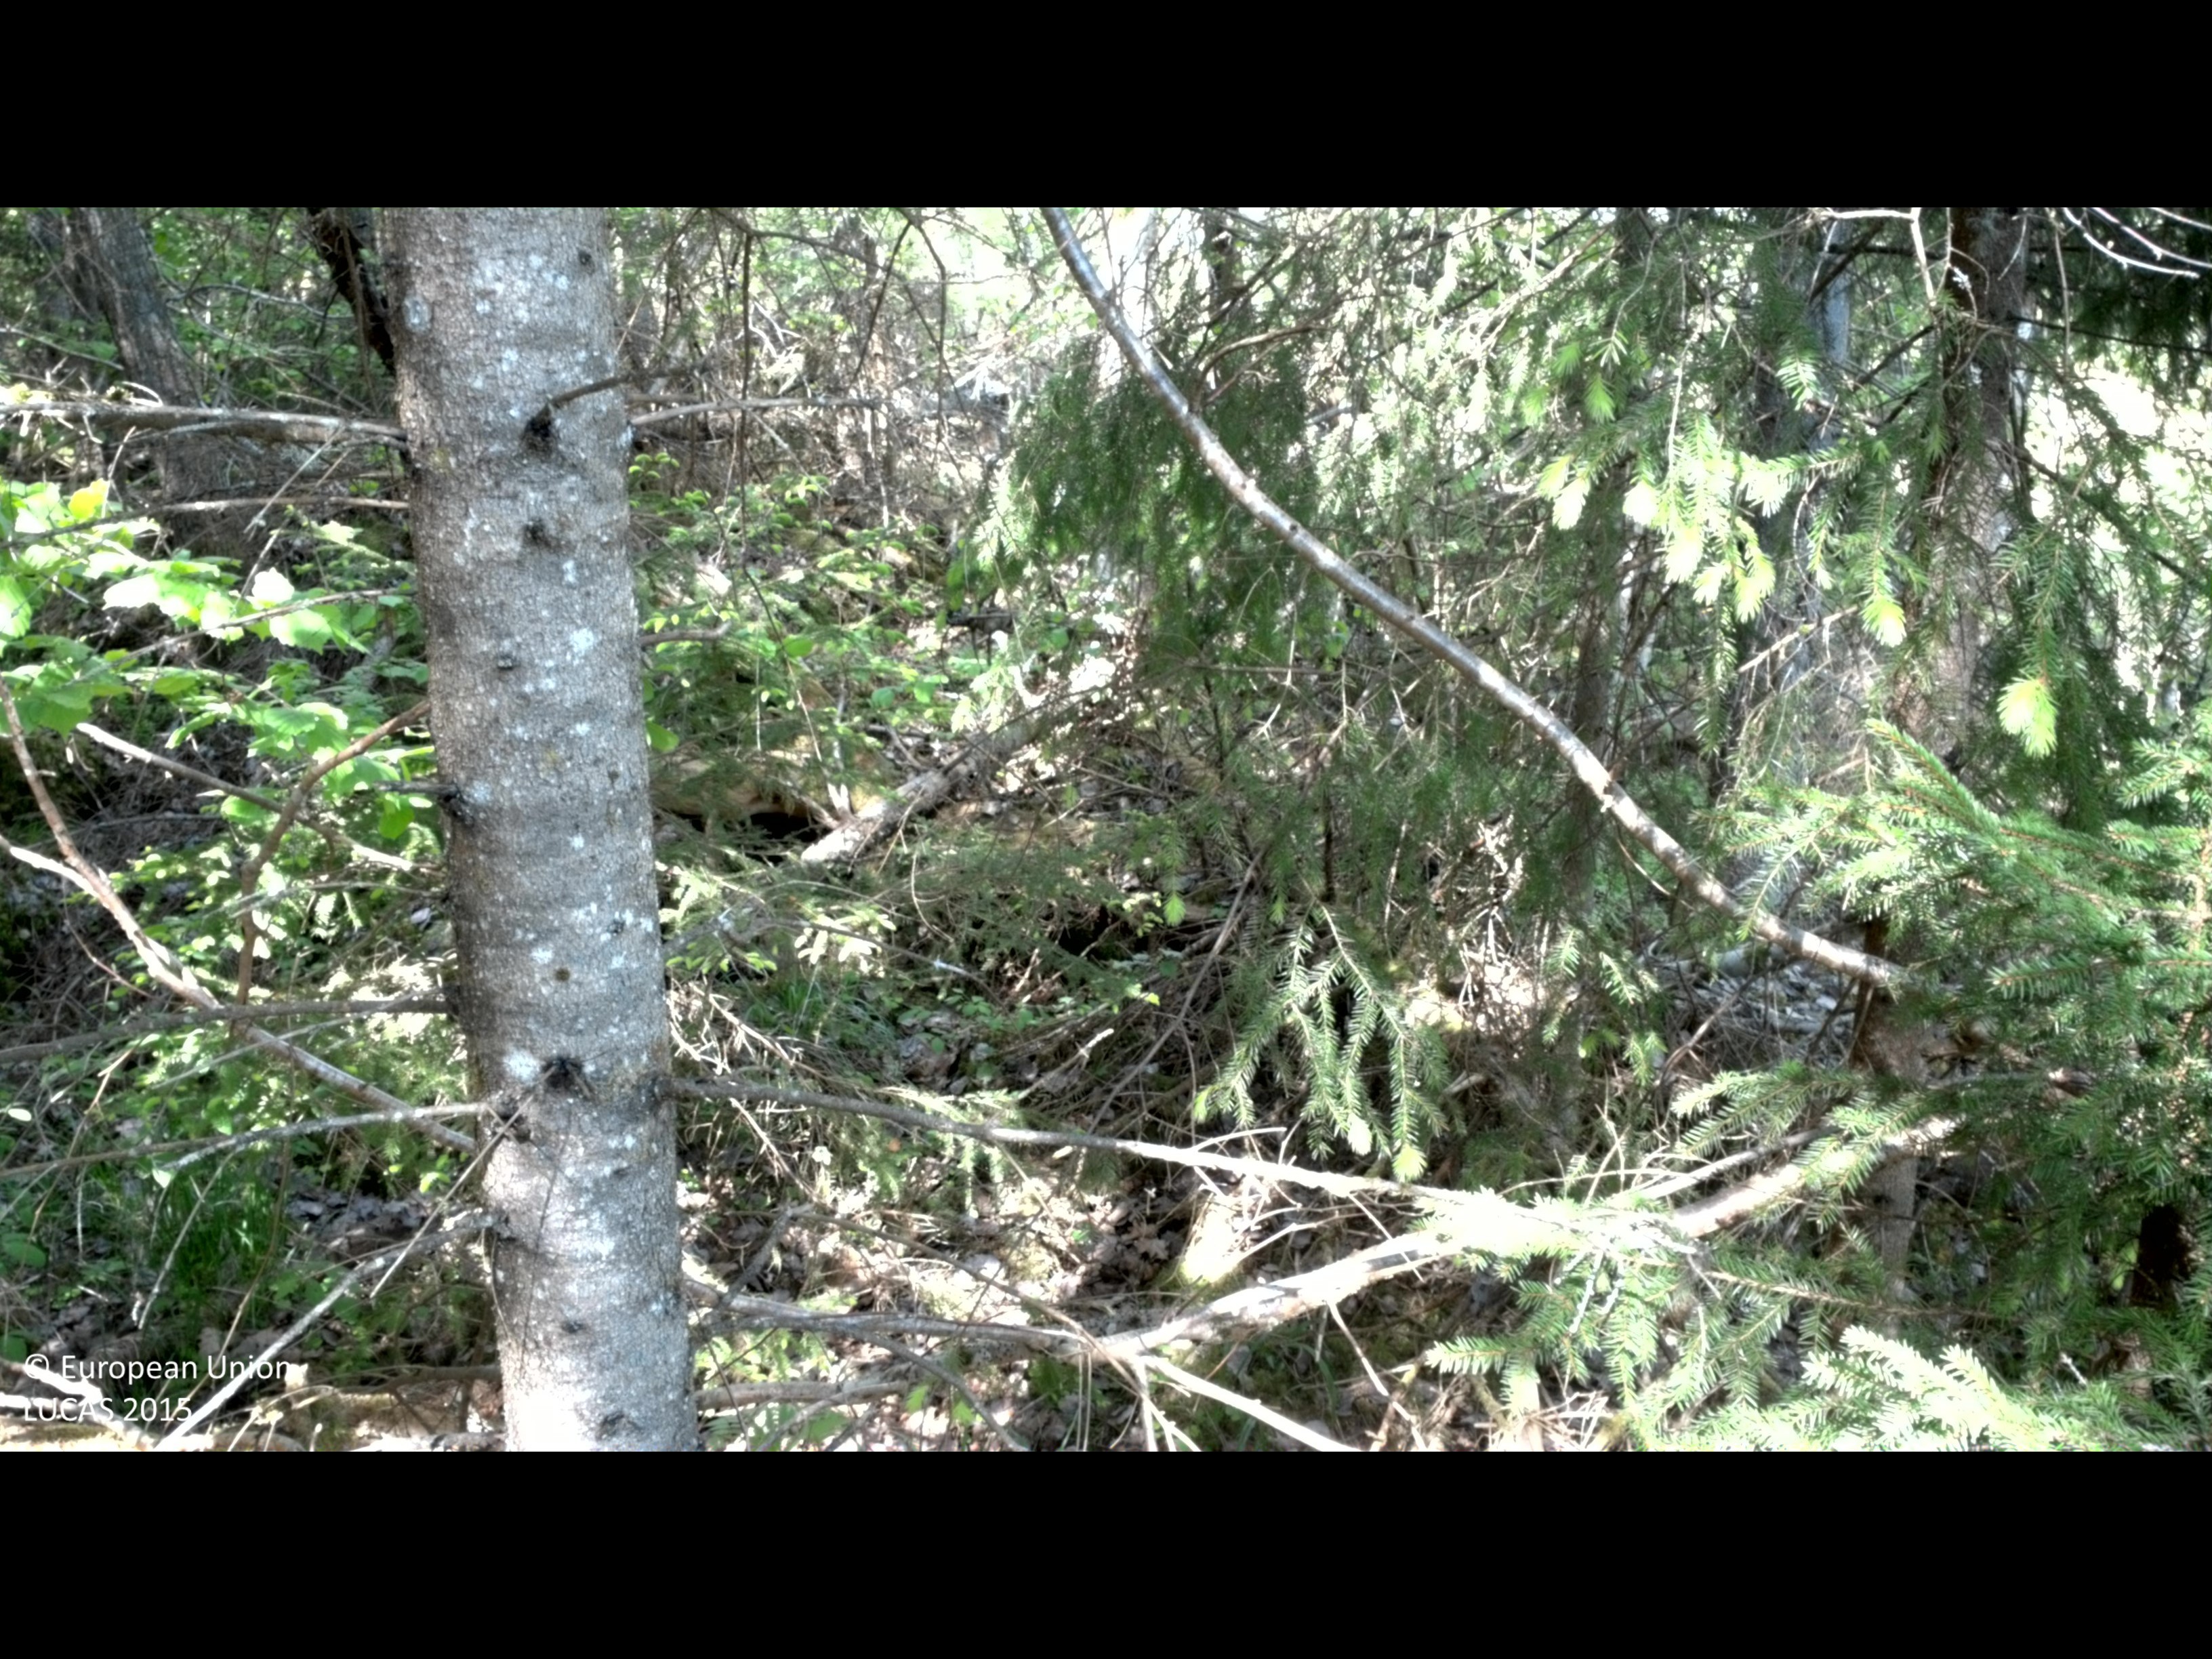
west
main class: Woodland
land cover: Spruce dominated mixed woodland
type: boreal forest
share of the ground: > 75 %
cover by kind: coniferous forest trees 65 %, broadleaved forest trees 25 %, shrubs 10 %
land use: Forestry
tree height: > 5 m
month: May
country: SE
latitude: 57.3983
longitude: 16.0388
